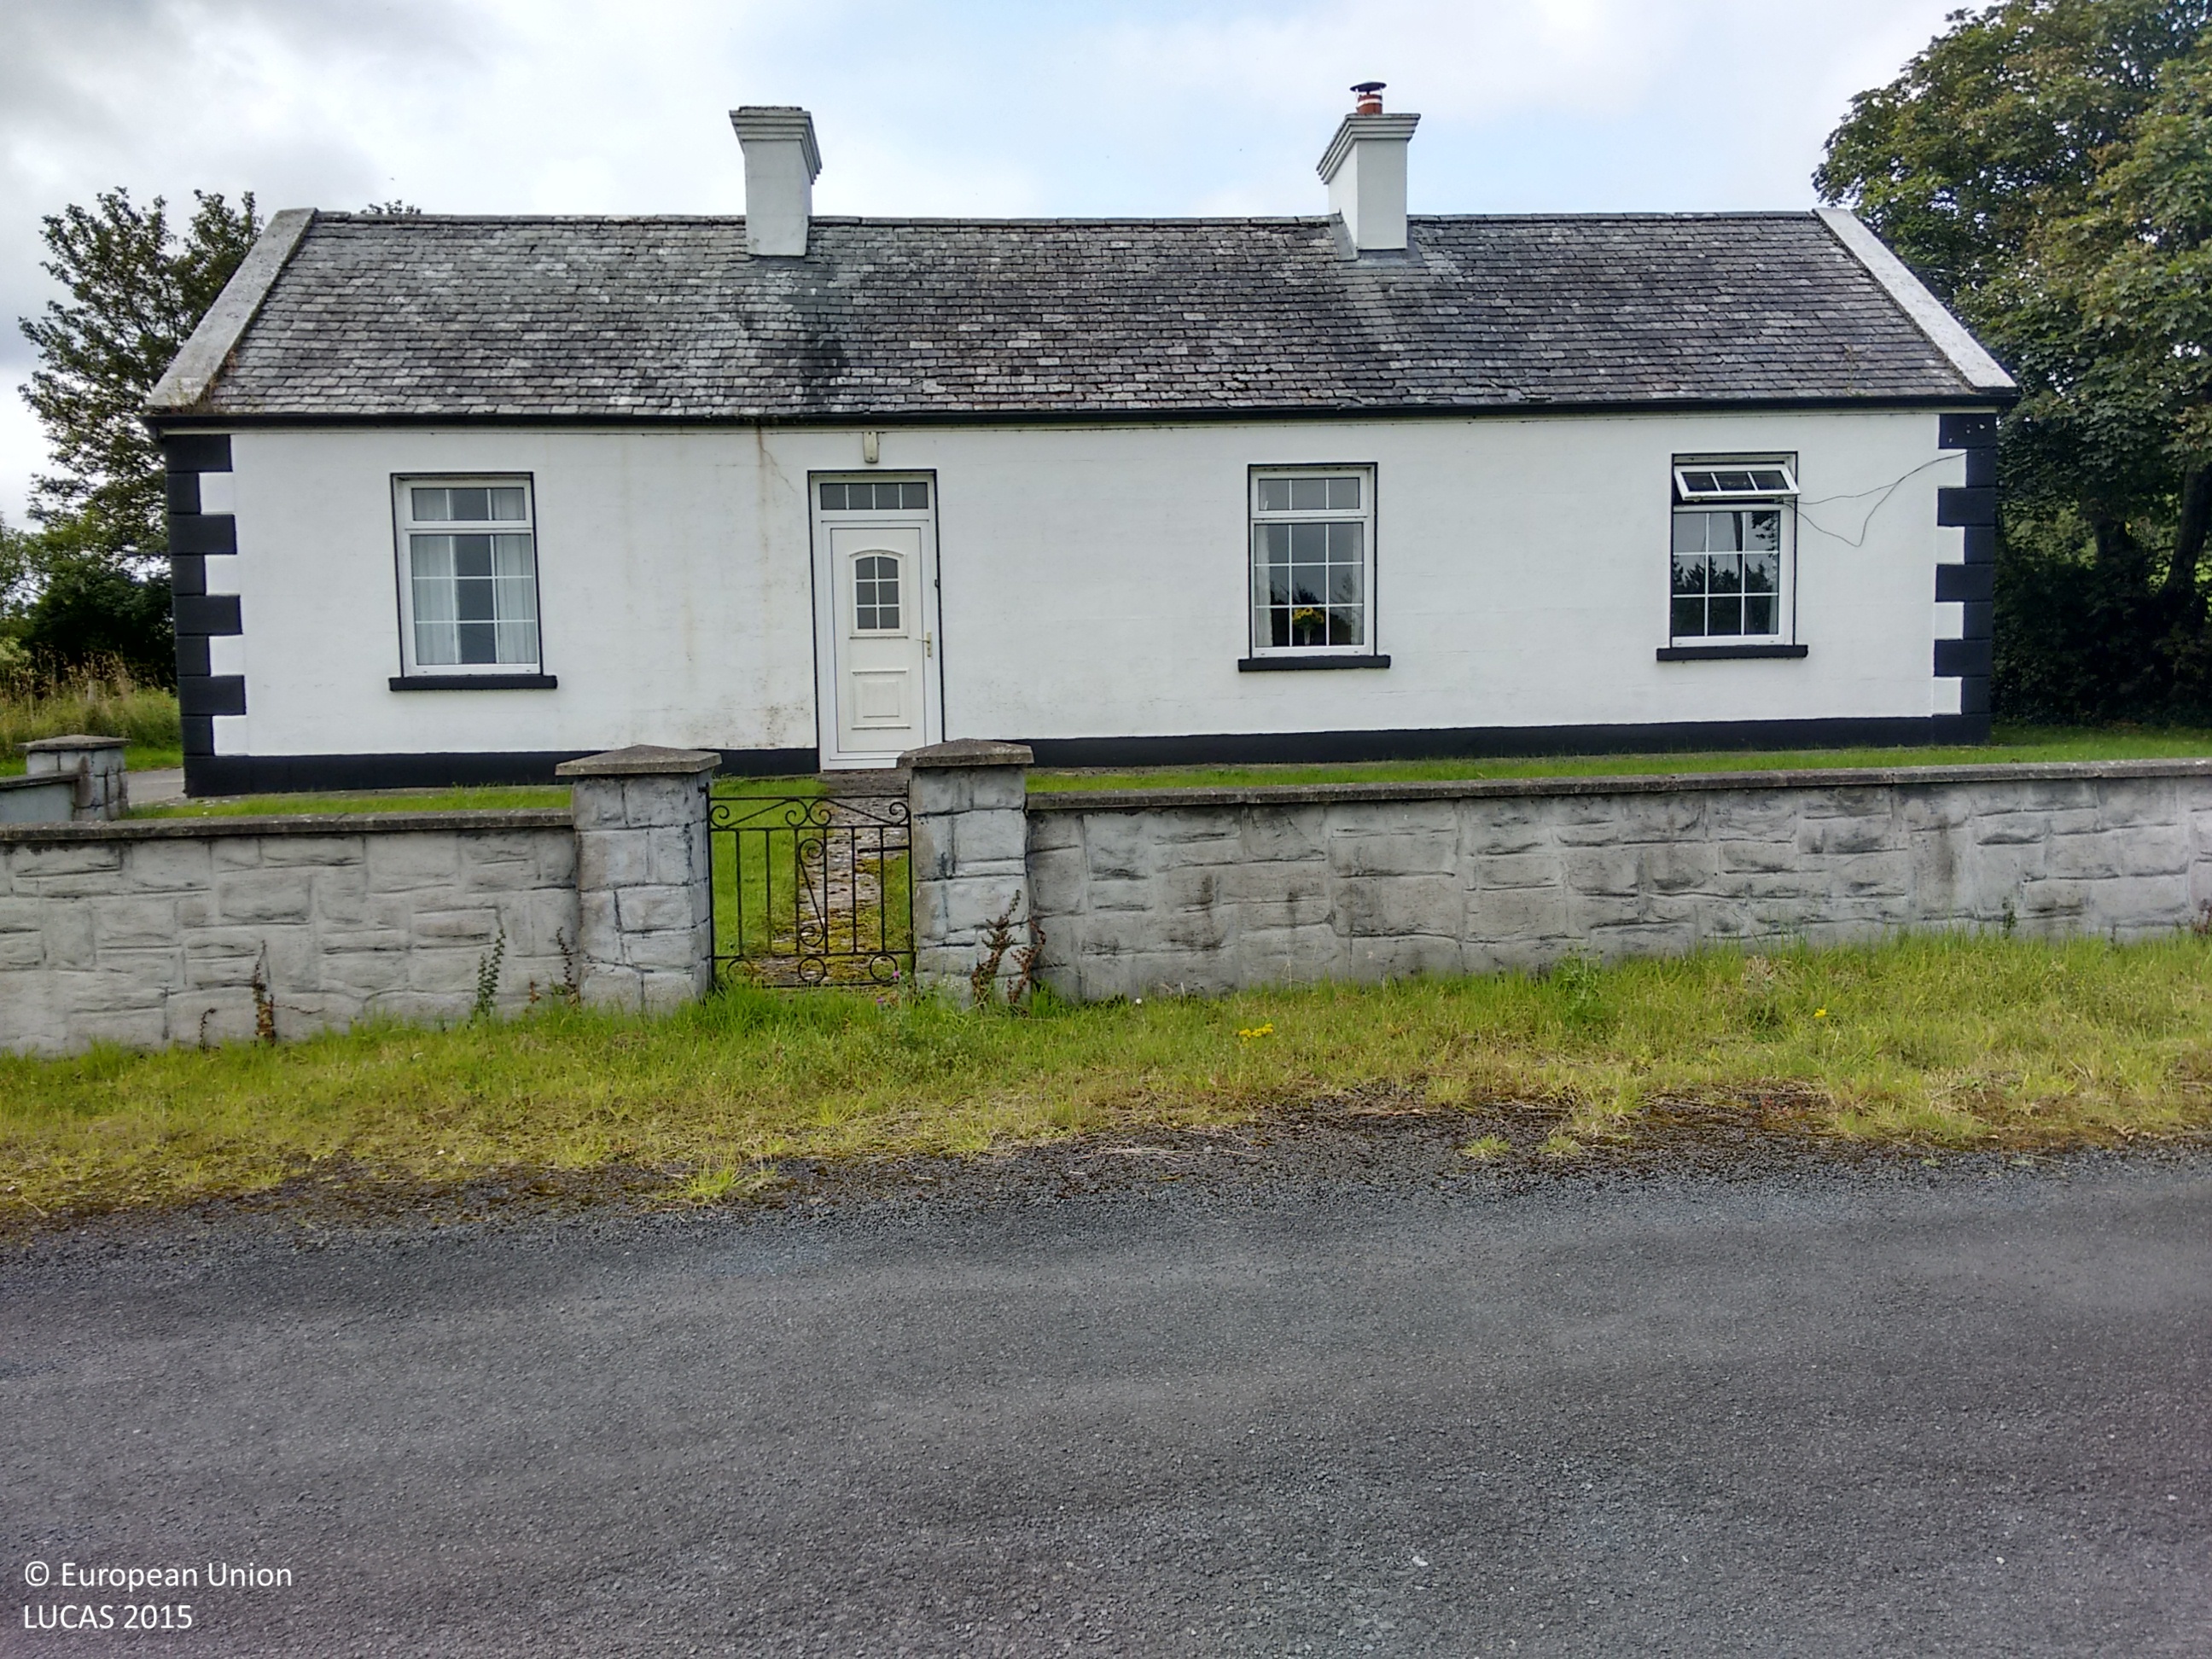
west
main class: Grassland
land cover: Grassland without tree/shrub cover
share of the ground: > 75 %
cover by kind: herbaceous plants 100 %
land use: Agriculture (excluding fallow land and kitchen gardens)
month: September
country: IE
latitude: 54.0943
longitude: -9.2580
